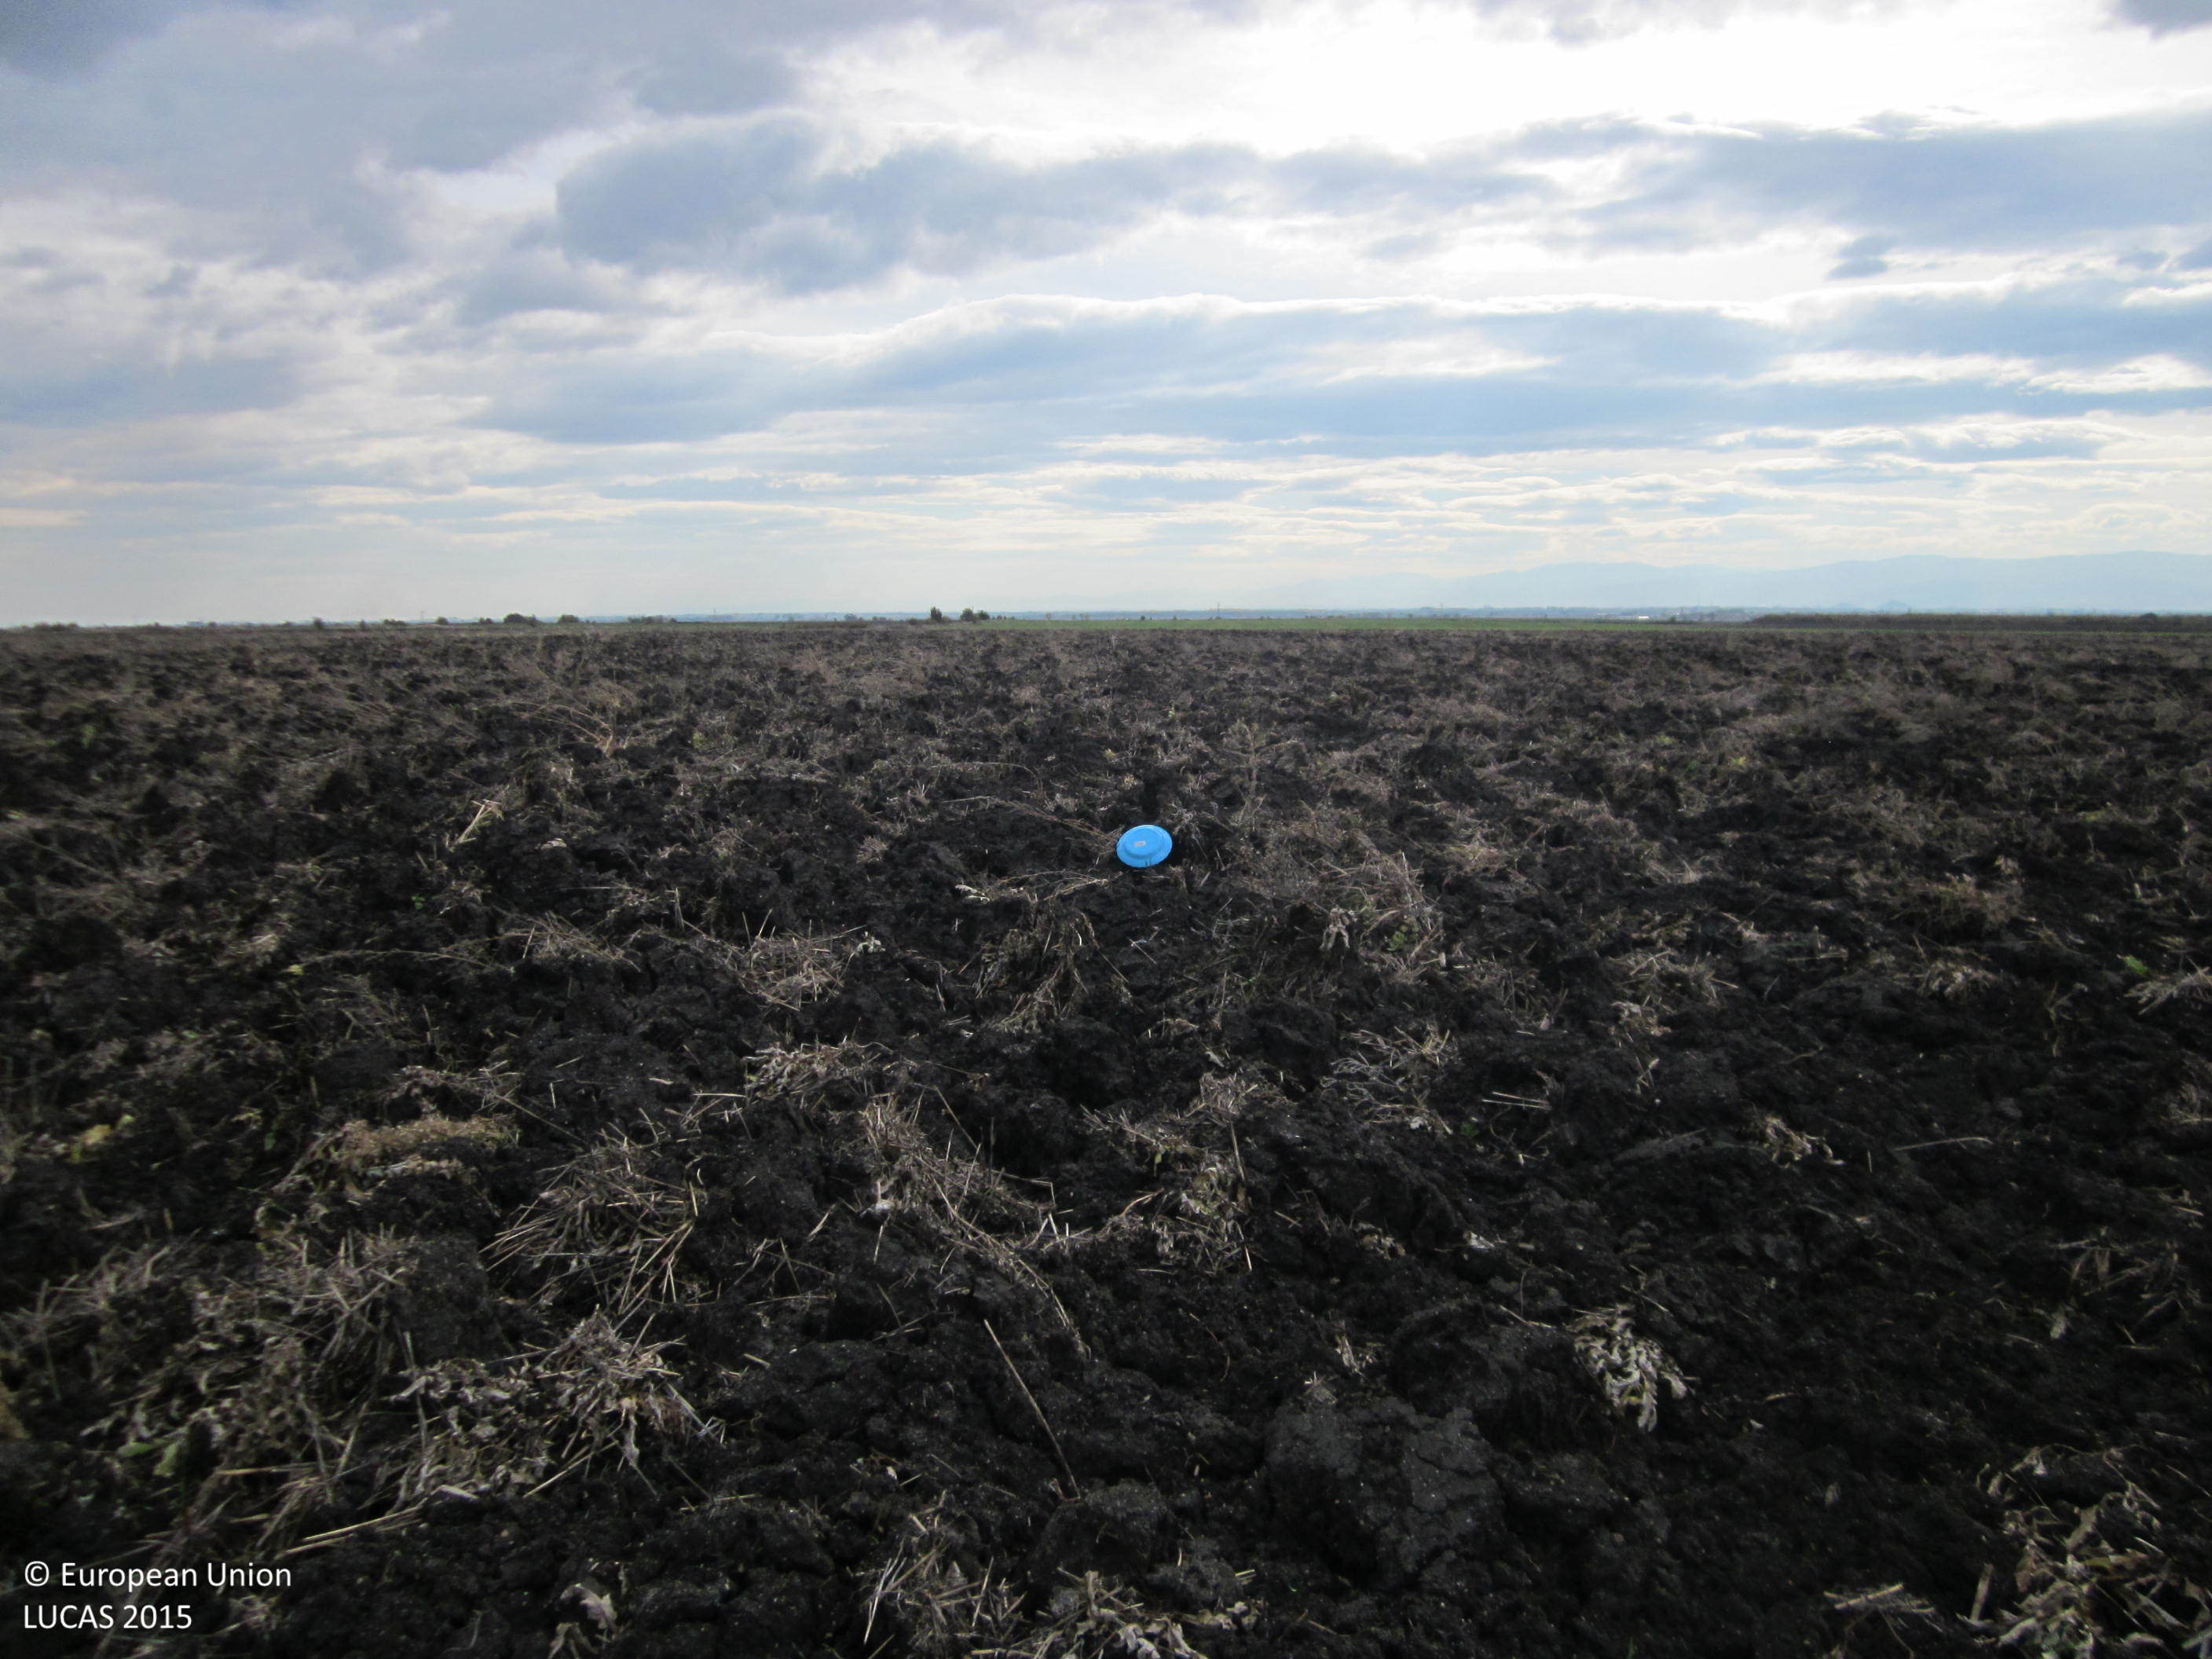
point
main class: Cropland
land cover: Common wheat
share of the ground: < 10 %
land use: Agriculture (excluding fallow land and kitchen gardens)
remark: Harvested field
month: November
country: BG
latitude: 42.3685
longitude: 24.6606
